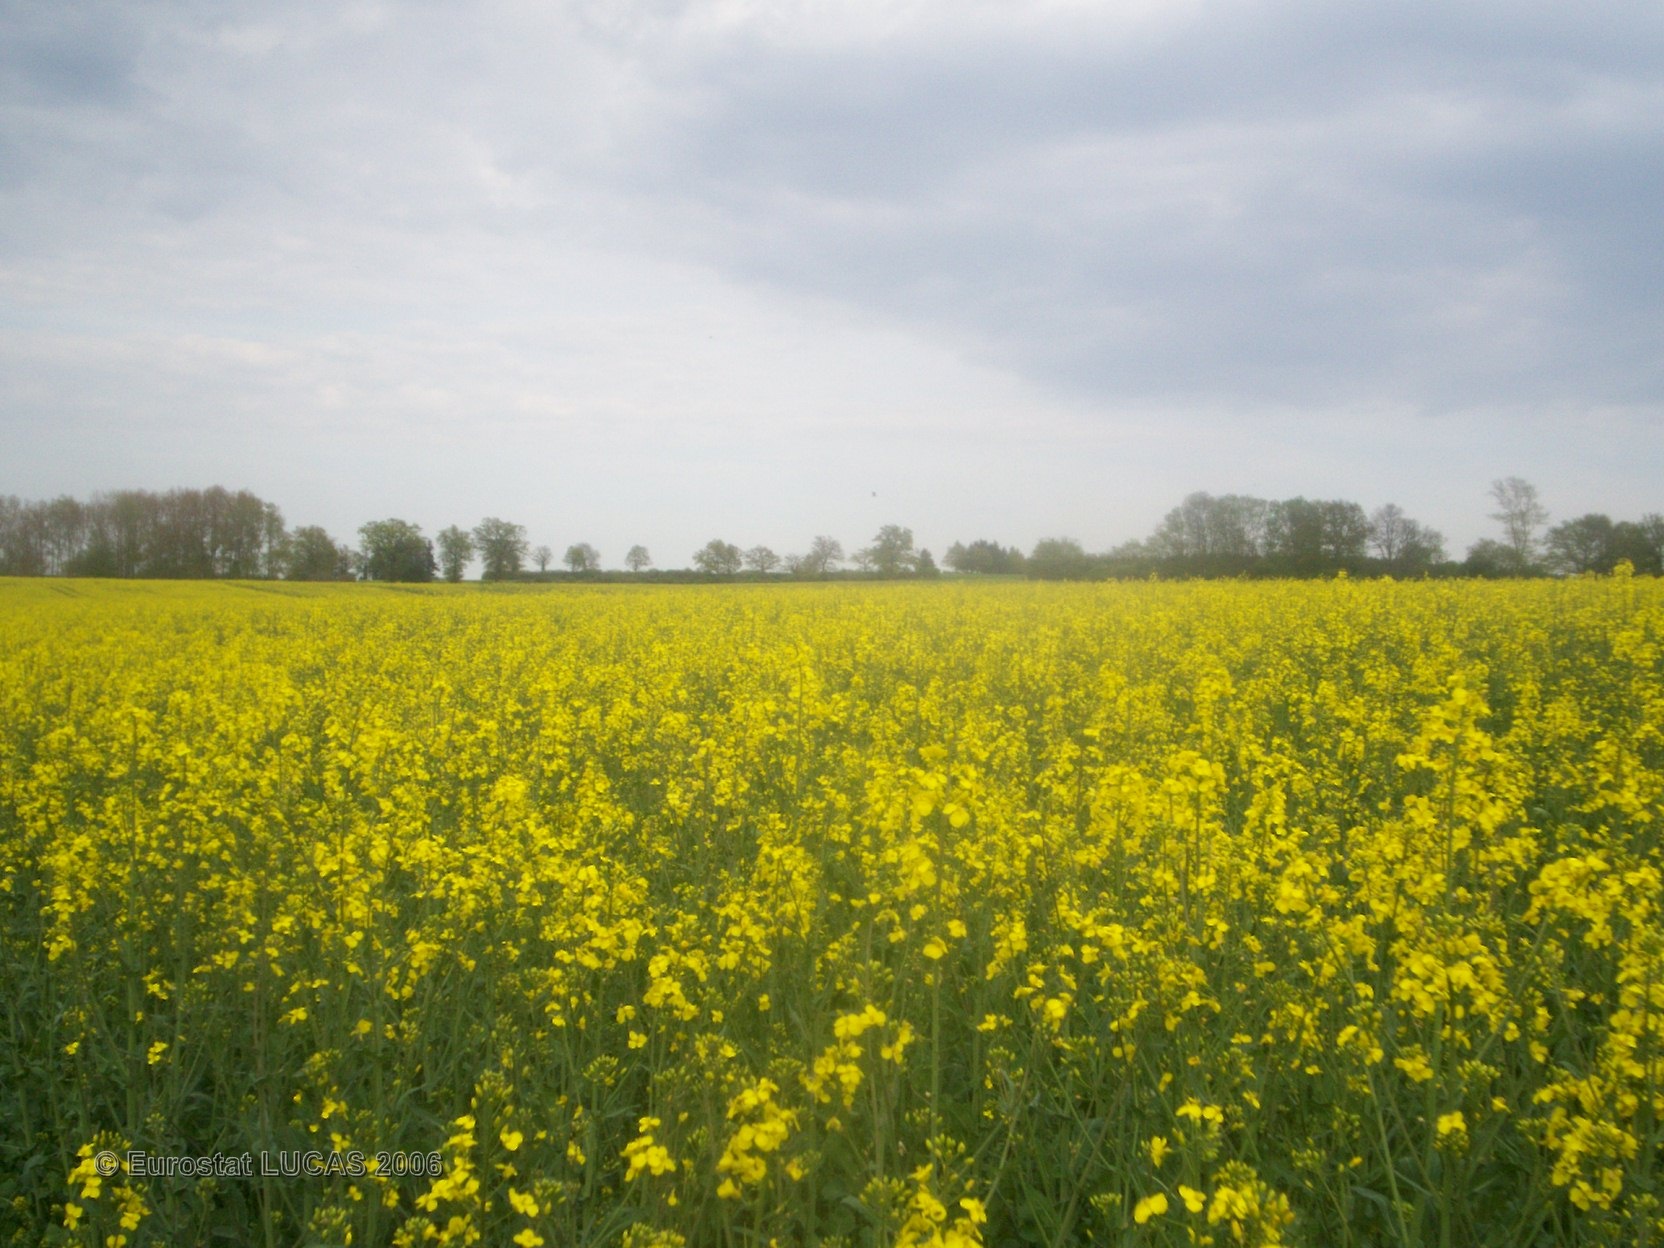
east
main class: Cropland
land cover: Rape and turnip rape
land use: Agriculture (excluding fallow land and kitchen gardens)
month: May
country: FR
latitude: 46.4705
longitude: 3.0822
